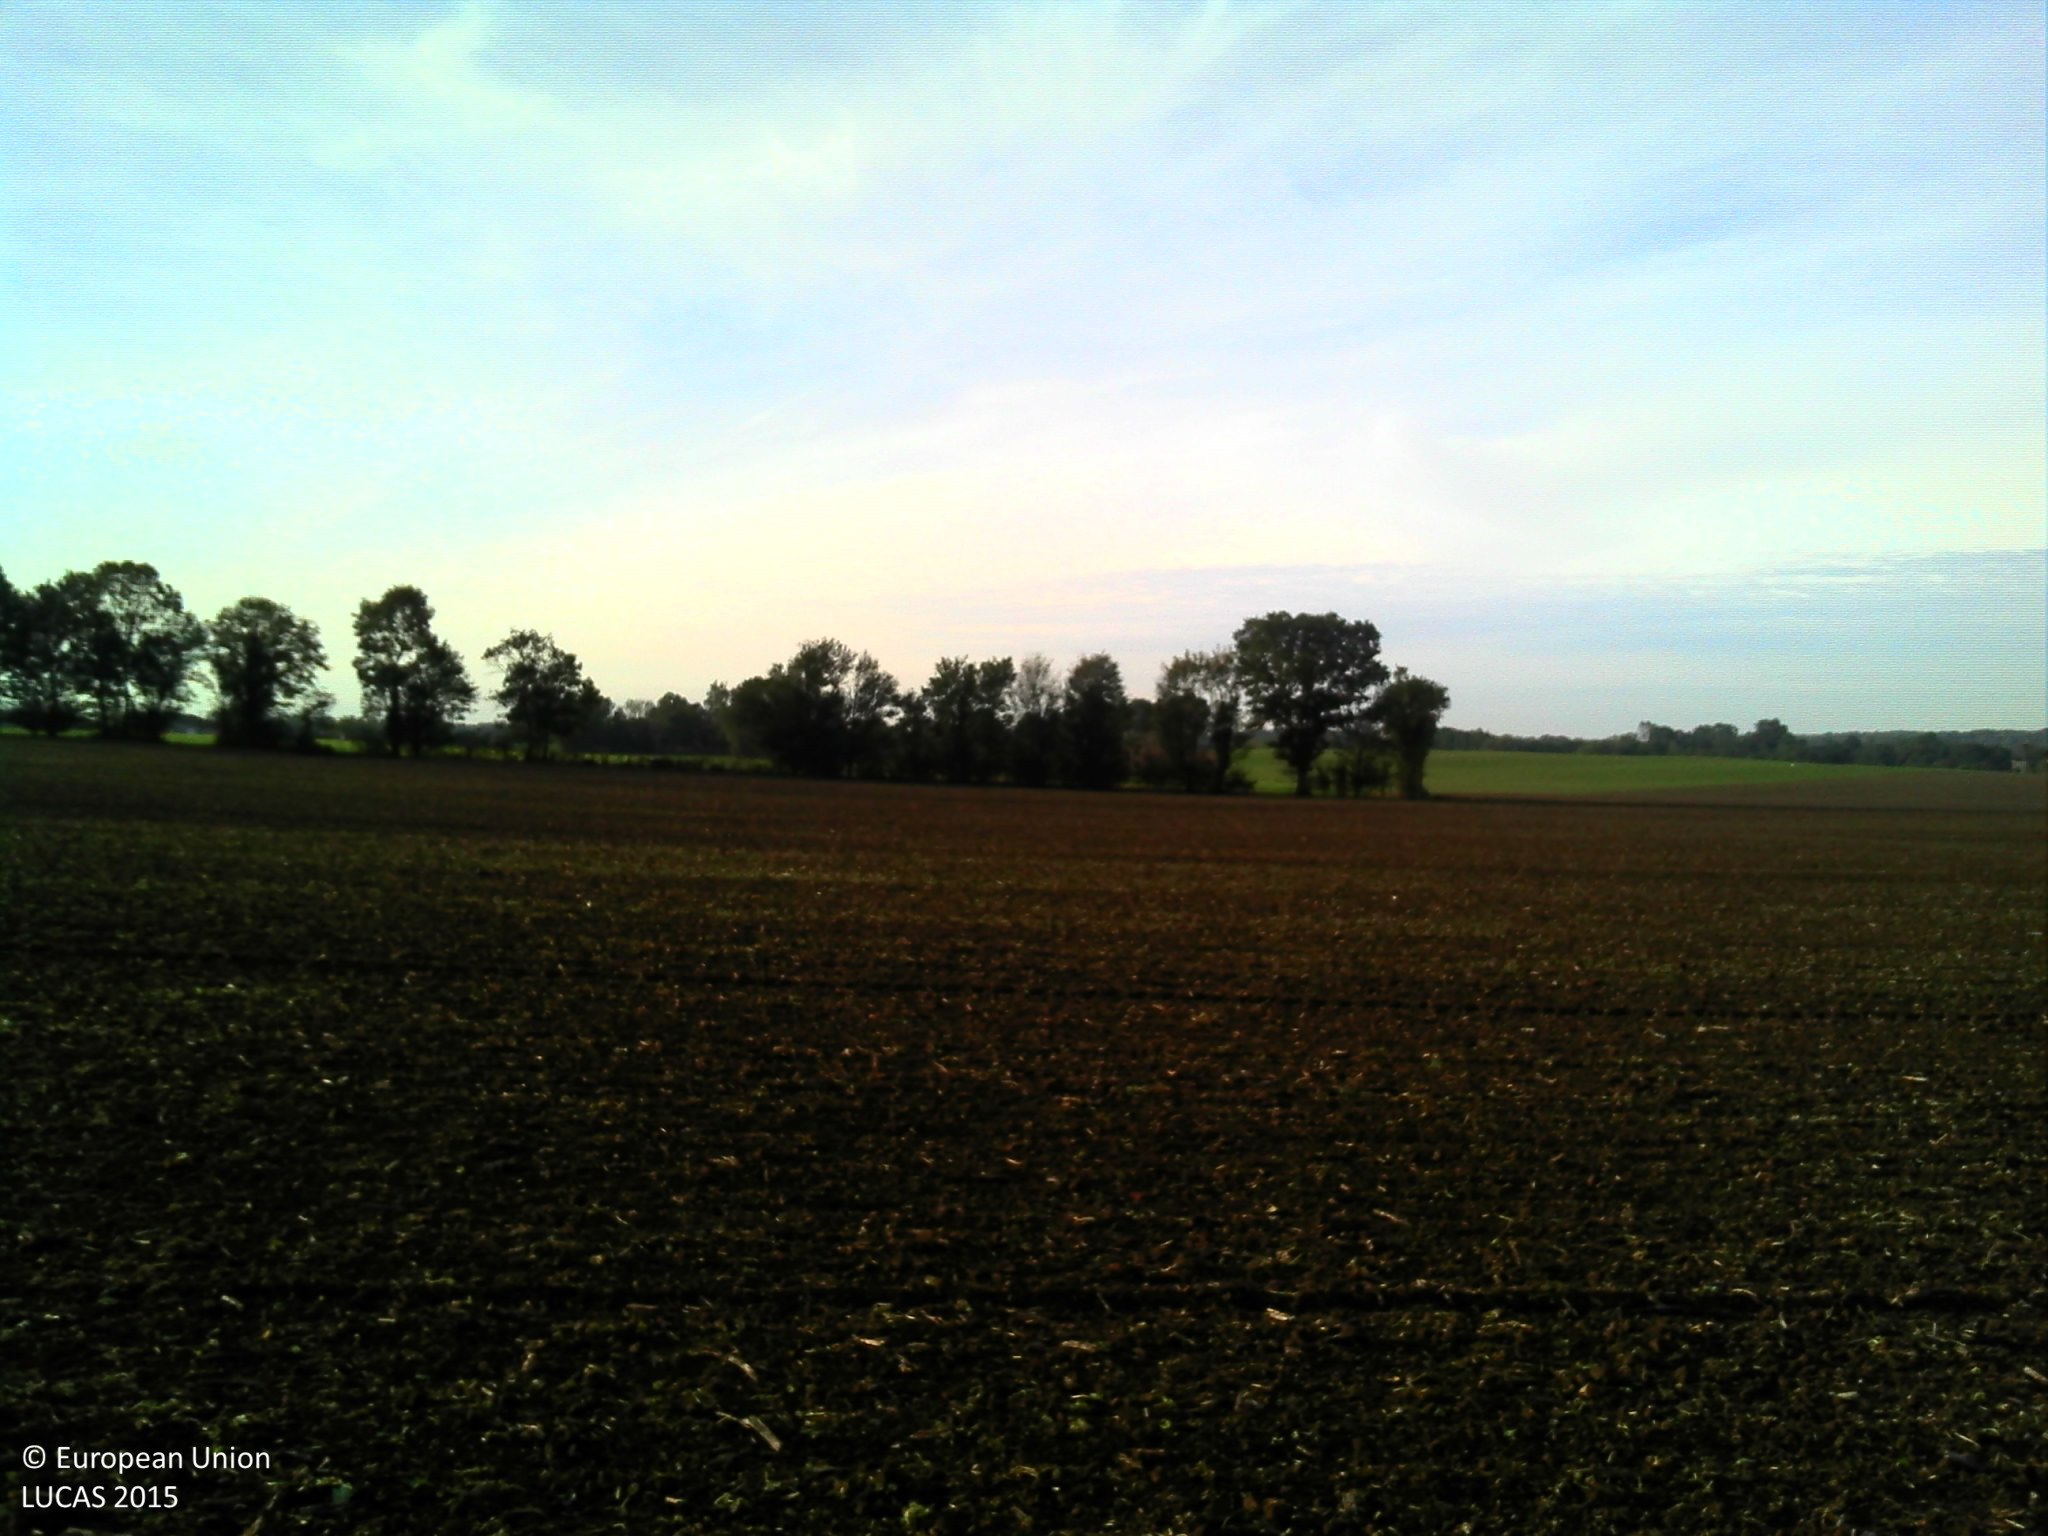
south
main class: Cropland
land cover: Sunflower
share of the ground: > 75 %
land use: Agriculture (excluding fallow land and kitchen gardens)
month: October
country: FR
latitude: 46.3989
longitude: 5.0470
